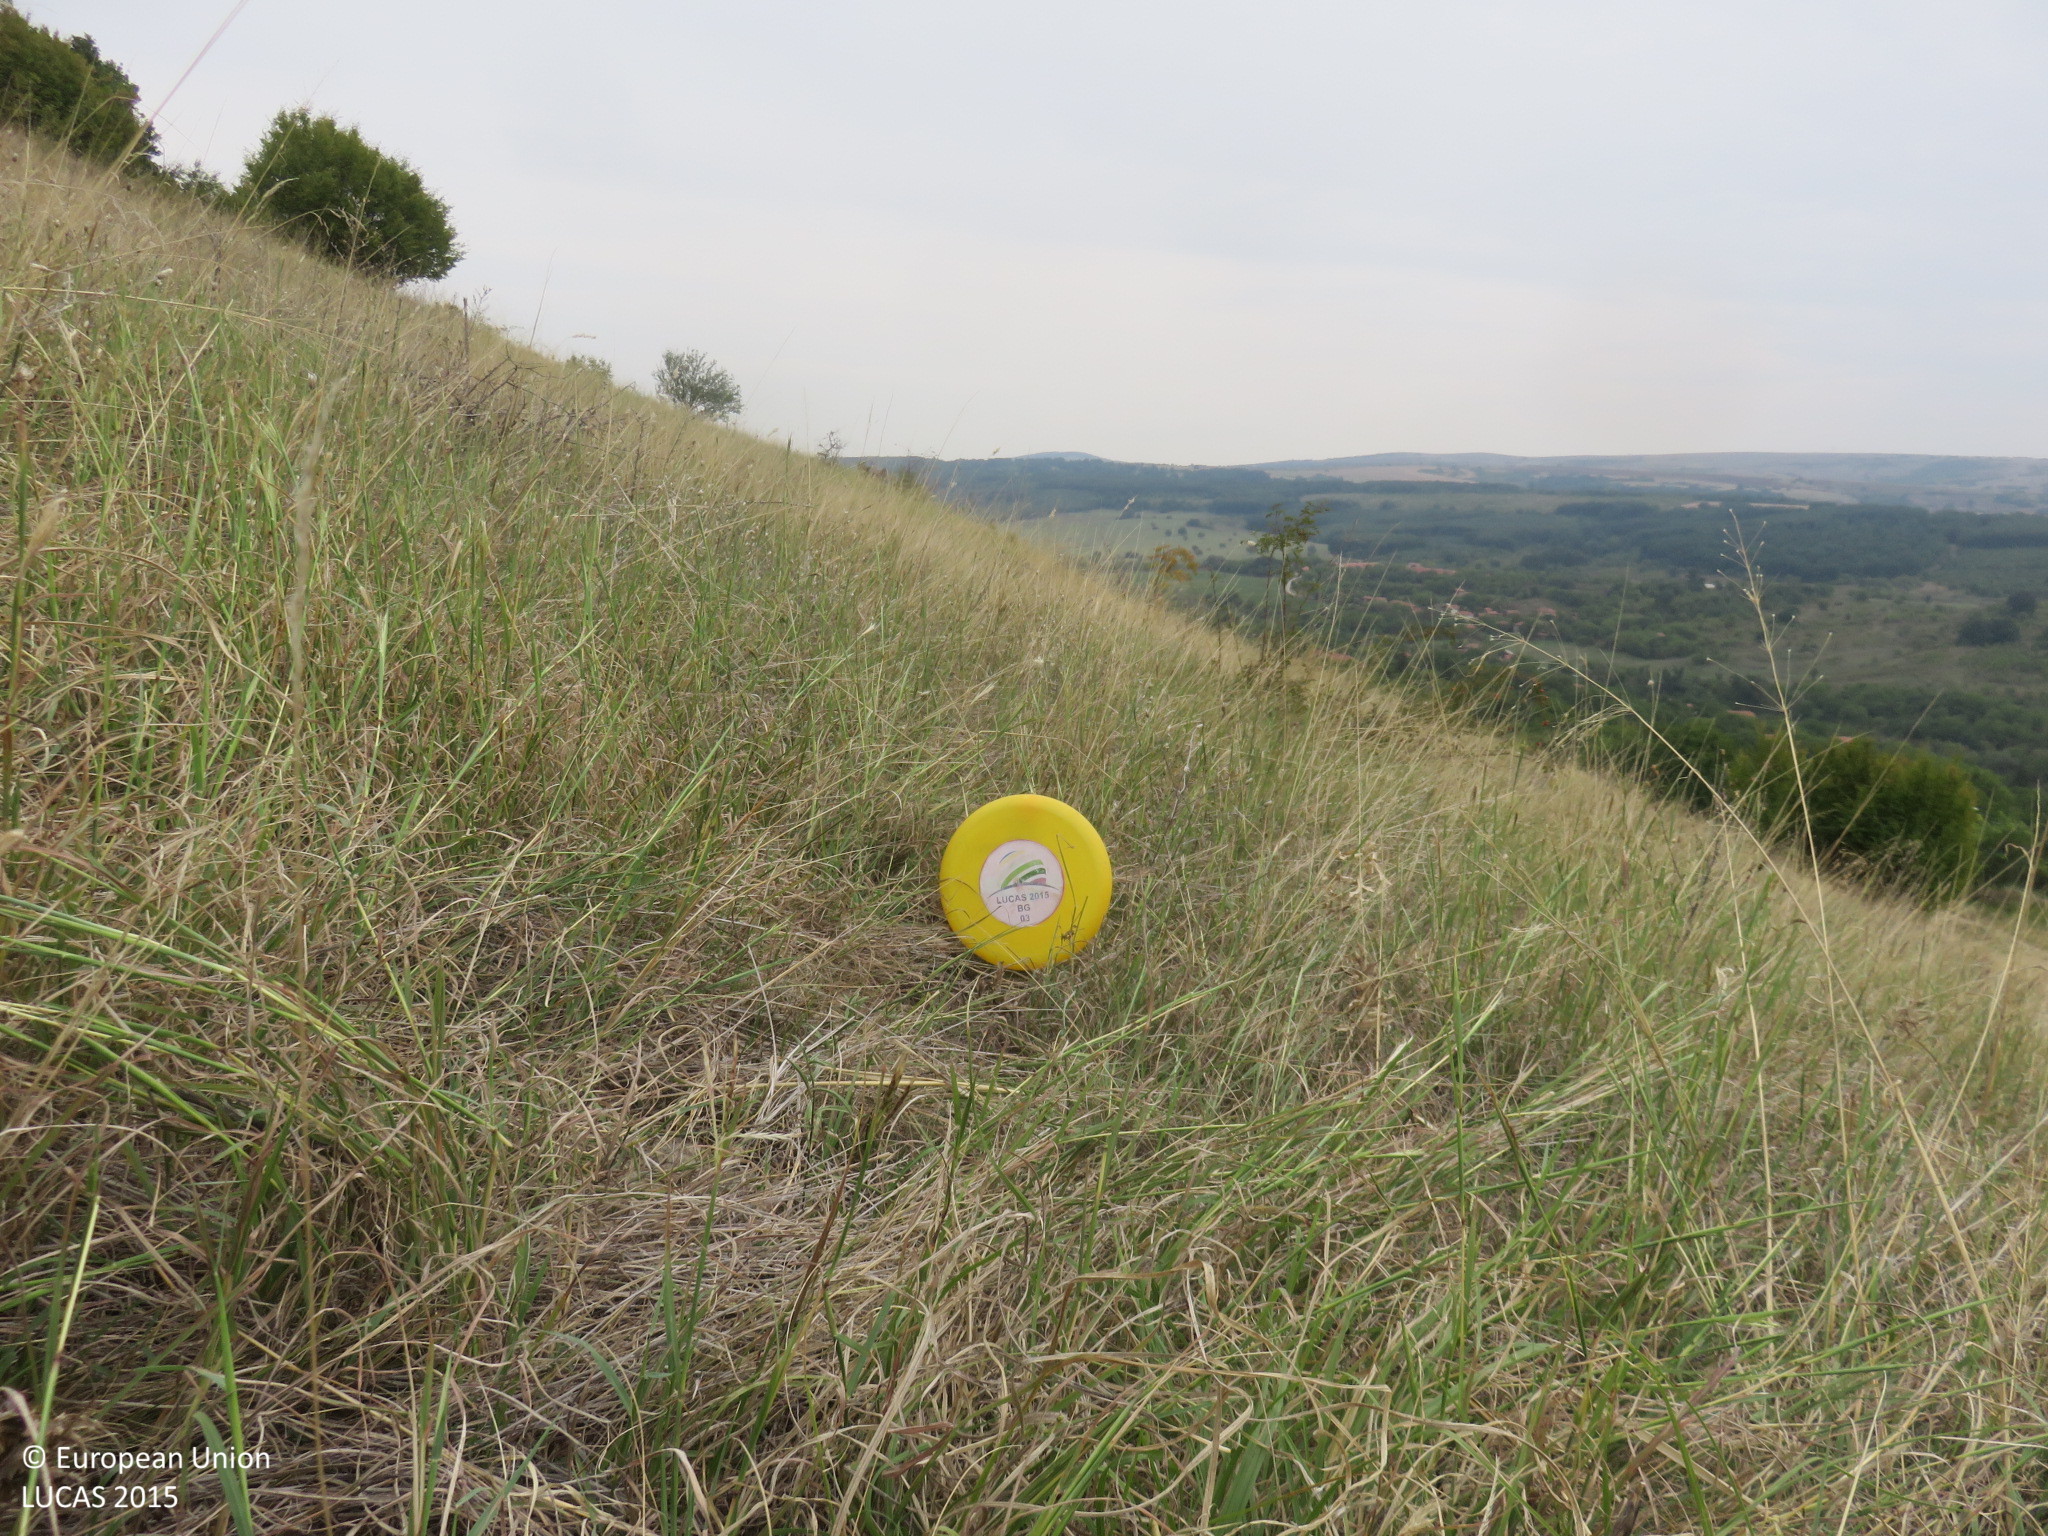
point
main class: Grassland
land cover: Grassland with sparse tree/shrub cover
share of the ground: > 75 %
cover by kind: herbaceous plants 90 %, broadleaved forest trees 5 %, shrubs 5 %
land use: Agriculture (excluding fallow land and kitchen gardens)
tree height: < 5 m
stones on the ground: 10 - 25 %
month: September
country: BG
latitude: 43.1776
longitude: 24.8898
